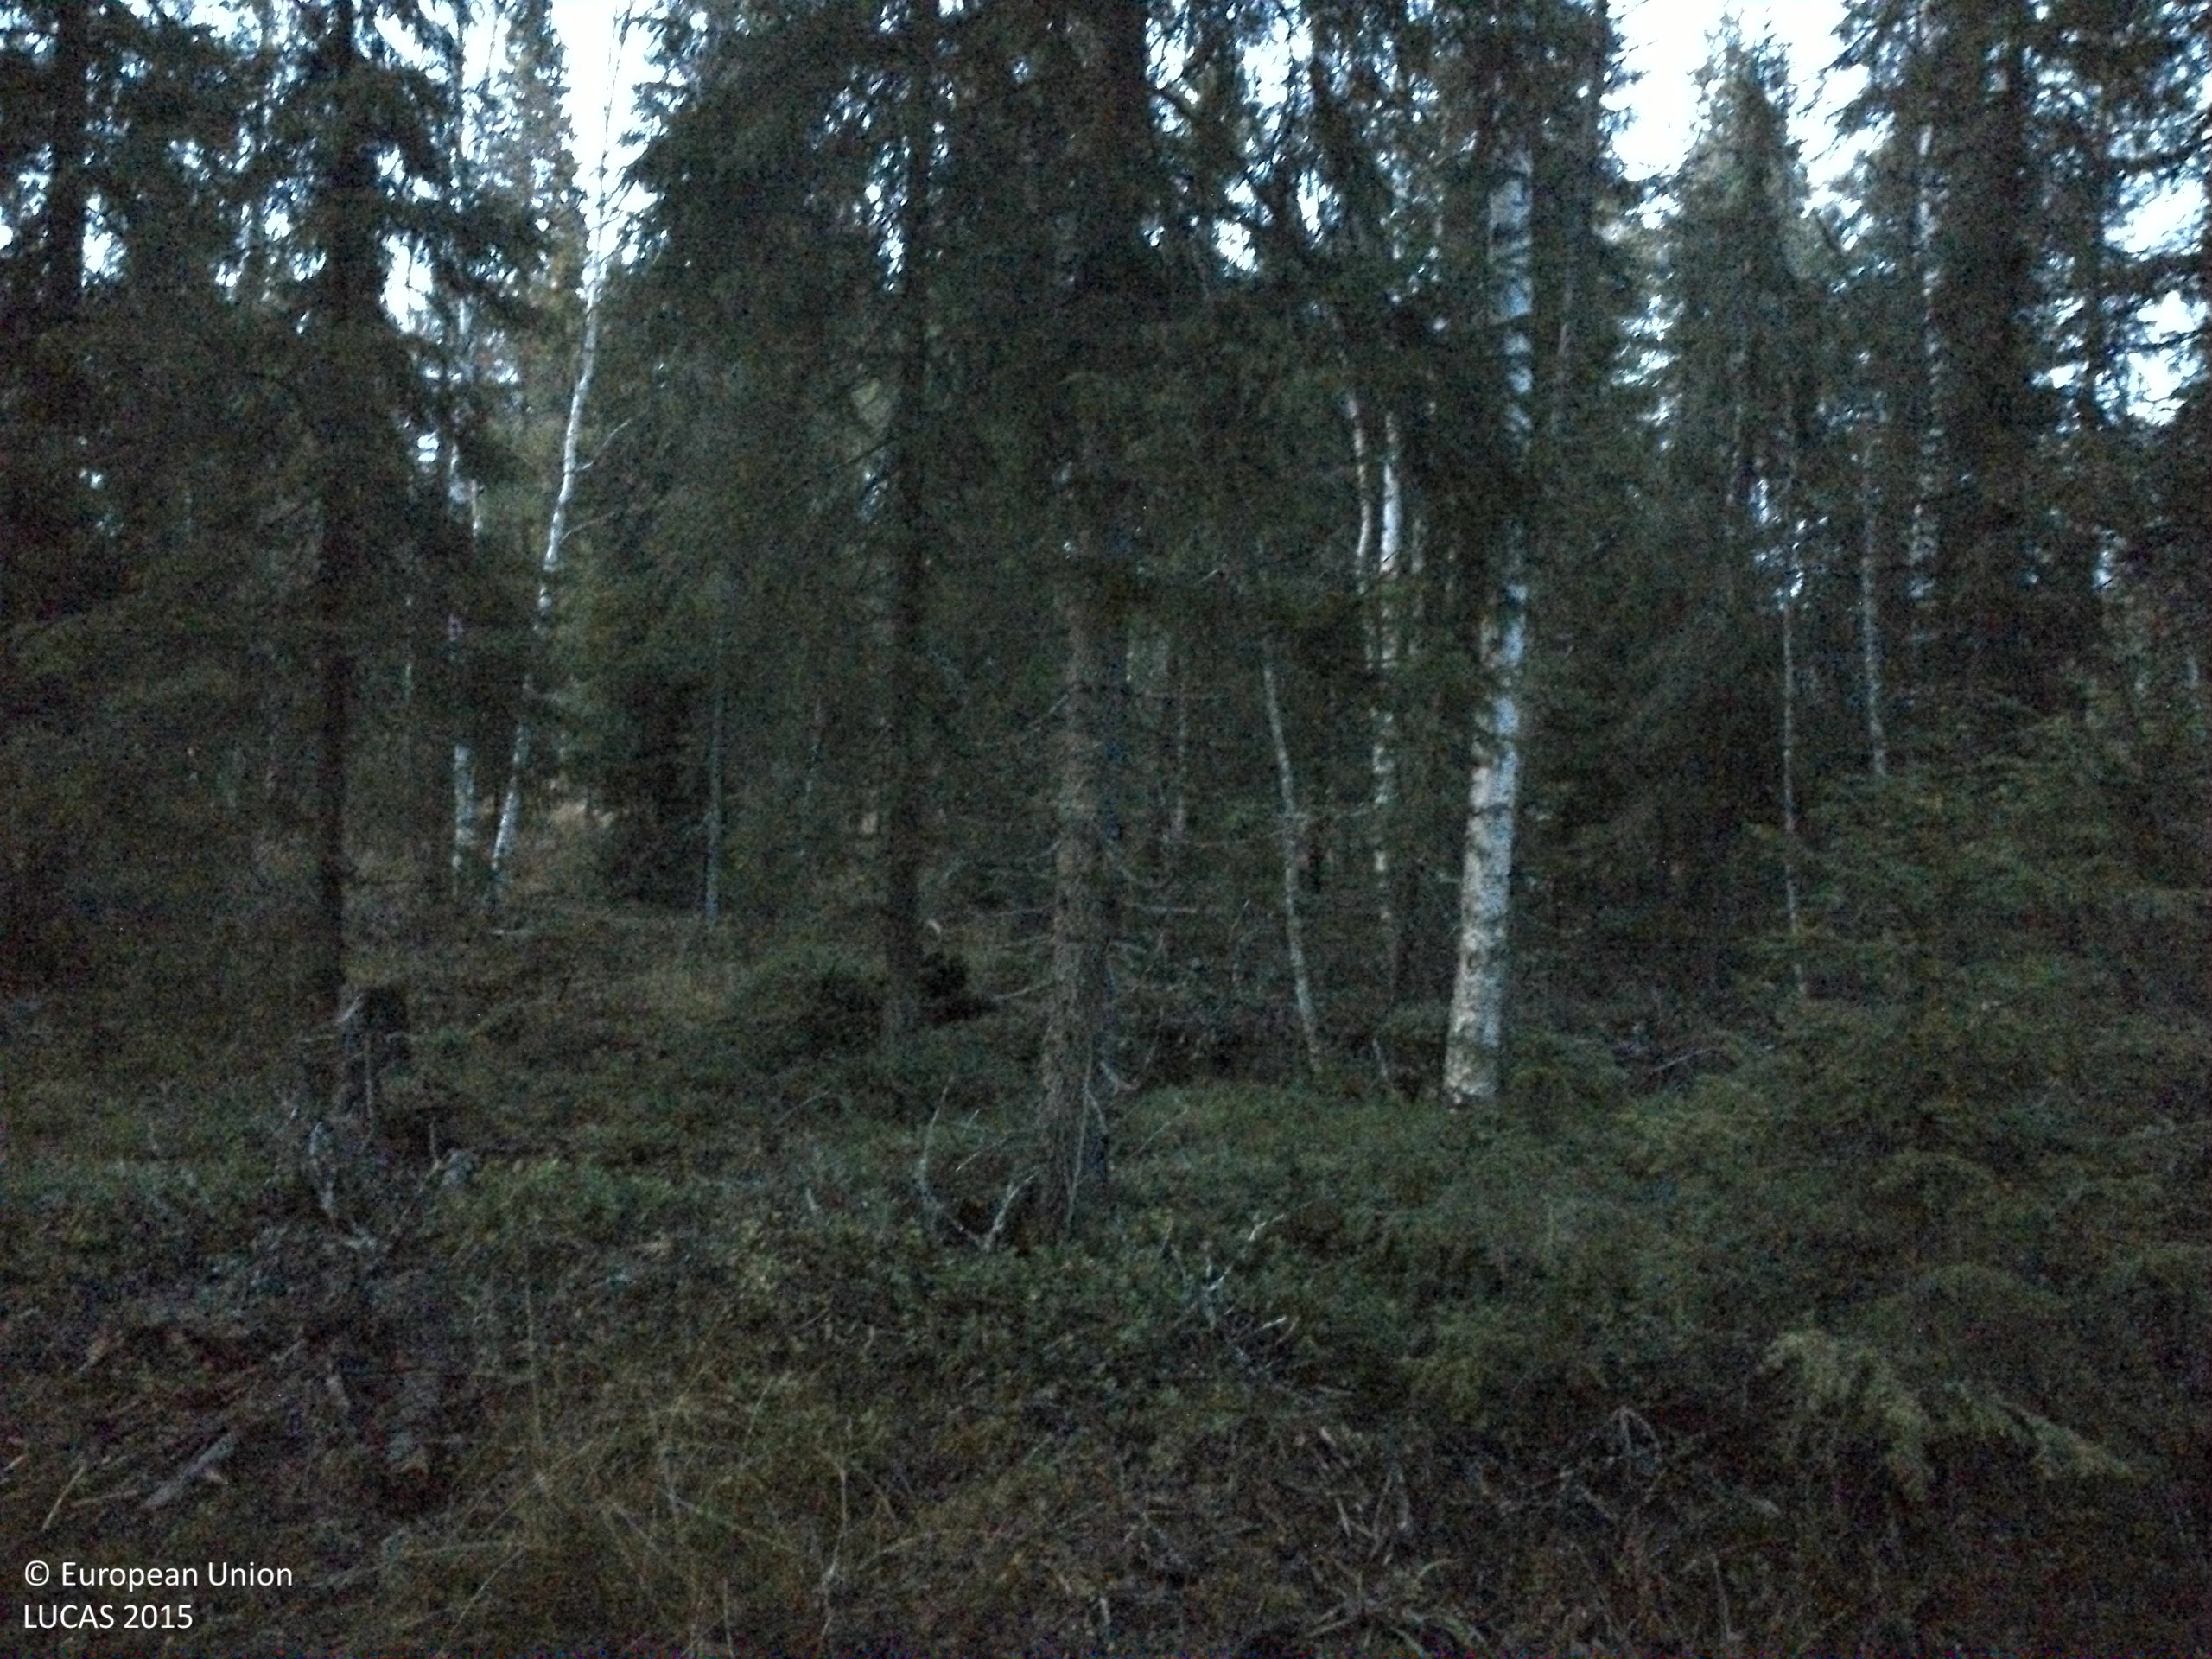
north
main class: Woodland
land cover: Other coniferous woodland
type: boreal forest
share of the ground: 50 - 75 %
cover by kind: coniferous forest trees 50 %, shrubs 30 %, lichens and mosses 15 %, broadleaved forest trees 5 %
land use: Forestry
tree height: > 5 m
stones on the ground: 10 - 25 %
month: October
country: SE
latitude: 63.7789
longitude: 15.4713
